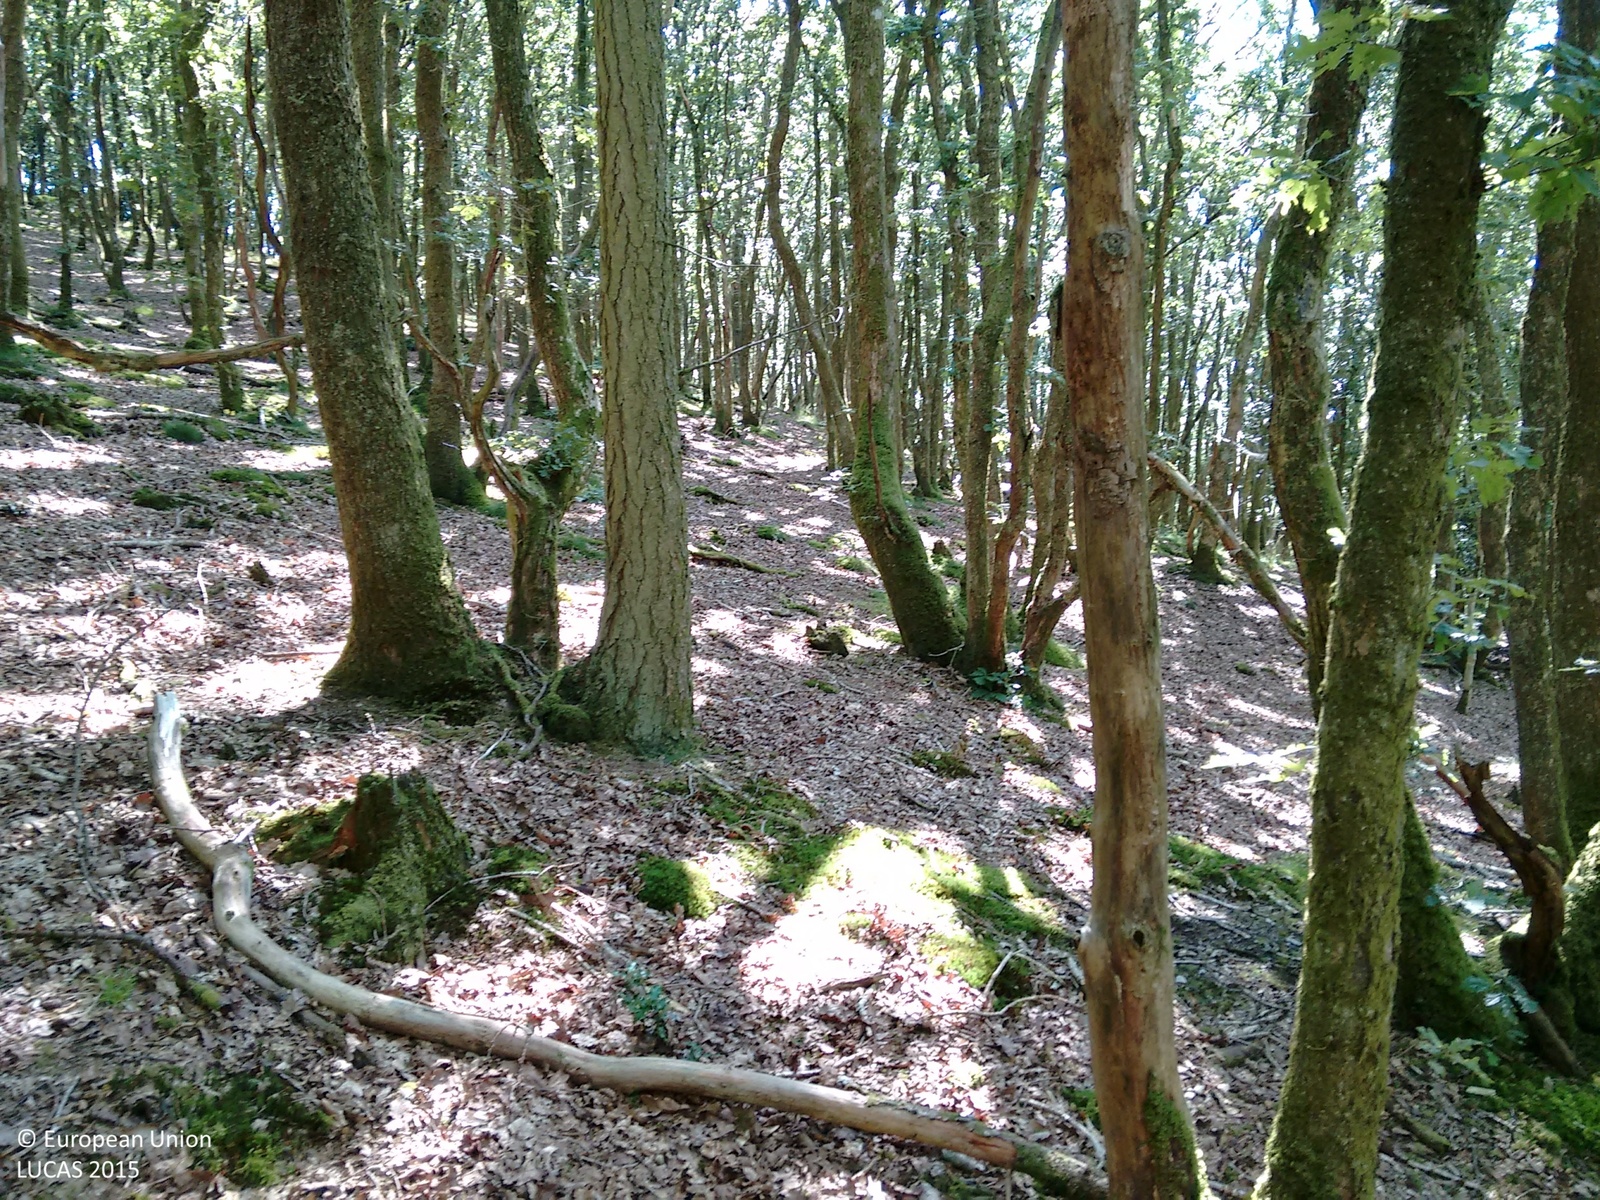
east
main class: Woodland
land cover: Broadleaved woodland
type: mesophytic deciduous forest
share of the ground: > 75 %
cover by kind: broadleaved forest trees 90 %, consolidated bare surface 10 %
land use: Semi-natural and natural areas not in use
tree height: > 5 m
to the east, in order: Broadleaved woodland; Fences; Grassland without tree/shrub cover; Fences; Abandoned hedges; Grassland without tree/shrub cover
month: August
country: GB
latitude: 52.0758
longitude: -4.1186
